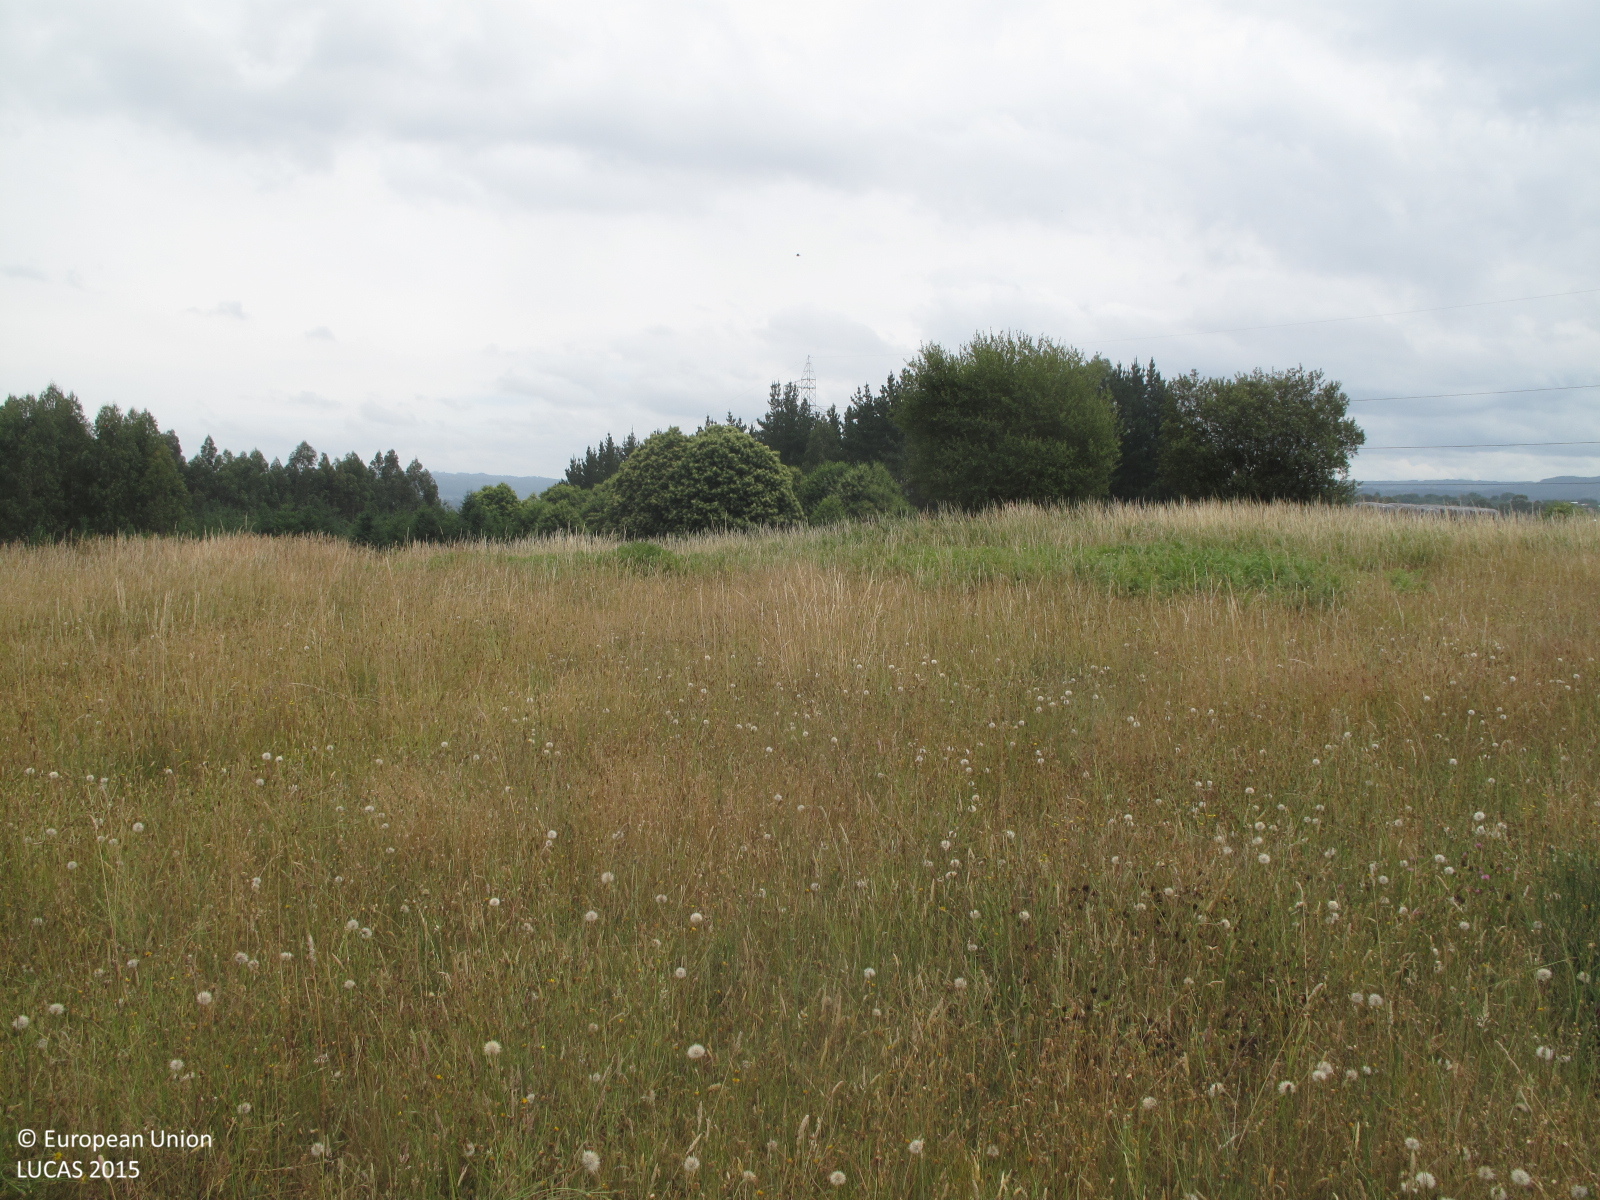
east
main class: Grassland
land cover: Spontaneously vegetated surfaces
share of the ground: > 75 %
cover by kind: herbaceous plants 100 %
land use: Abandoned areas
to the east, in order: Spontaneously vegetated surfaces; Grassland without tree/shrub cover; Broadleaved woodland; Pine dominated coniferous woodland; Shrubland without tree cover; Electric lines
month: July
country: ES
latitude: 43.2559
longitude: -8.2194
